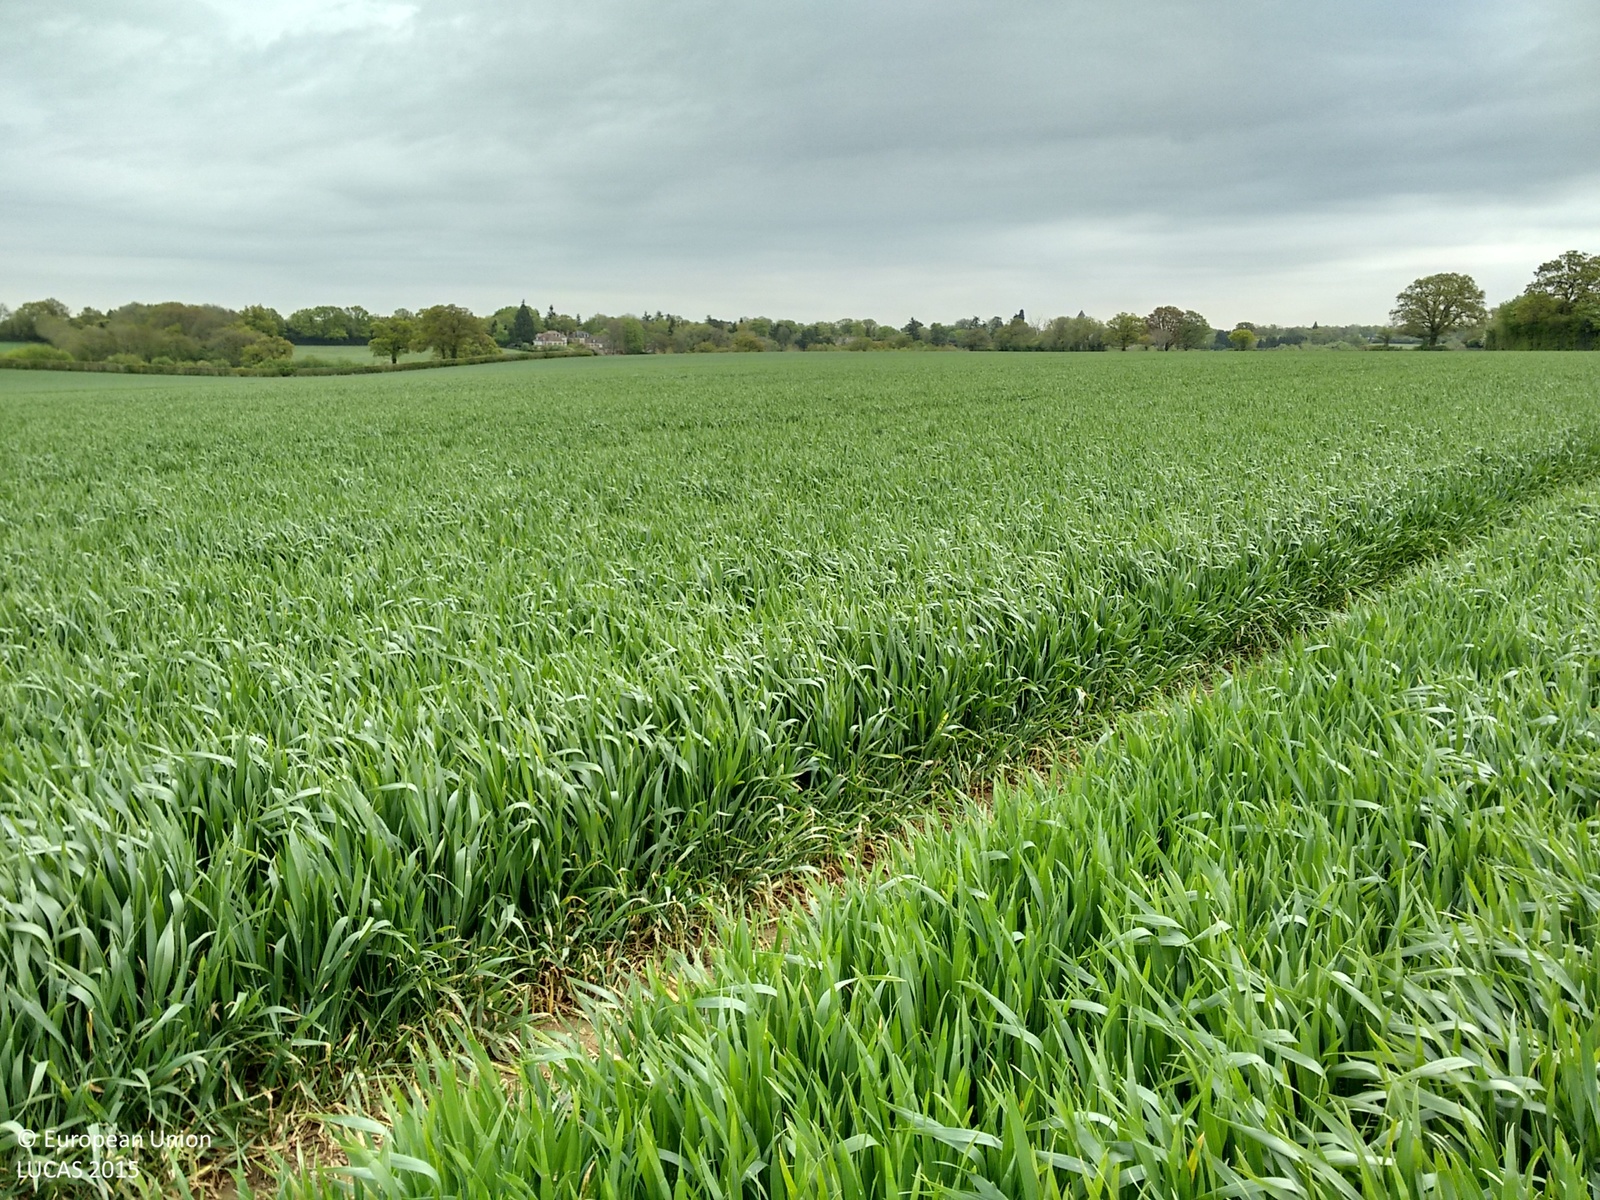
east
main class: Cropland
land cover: Common wheat
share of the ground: > 75 %
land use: Agriculture (excluding fallow land and kitchen gardens)
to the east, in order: Common wheat
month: May
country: GB
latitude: 51.7563
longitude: -0.6006
